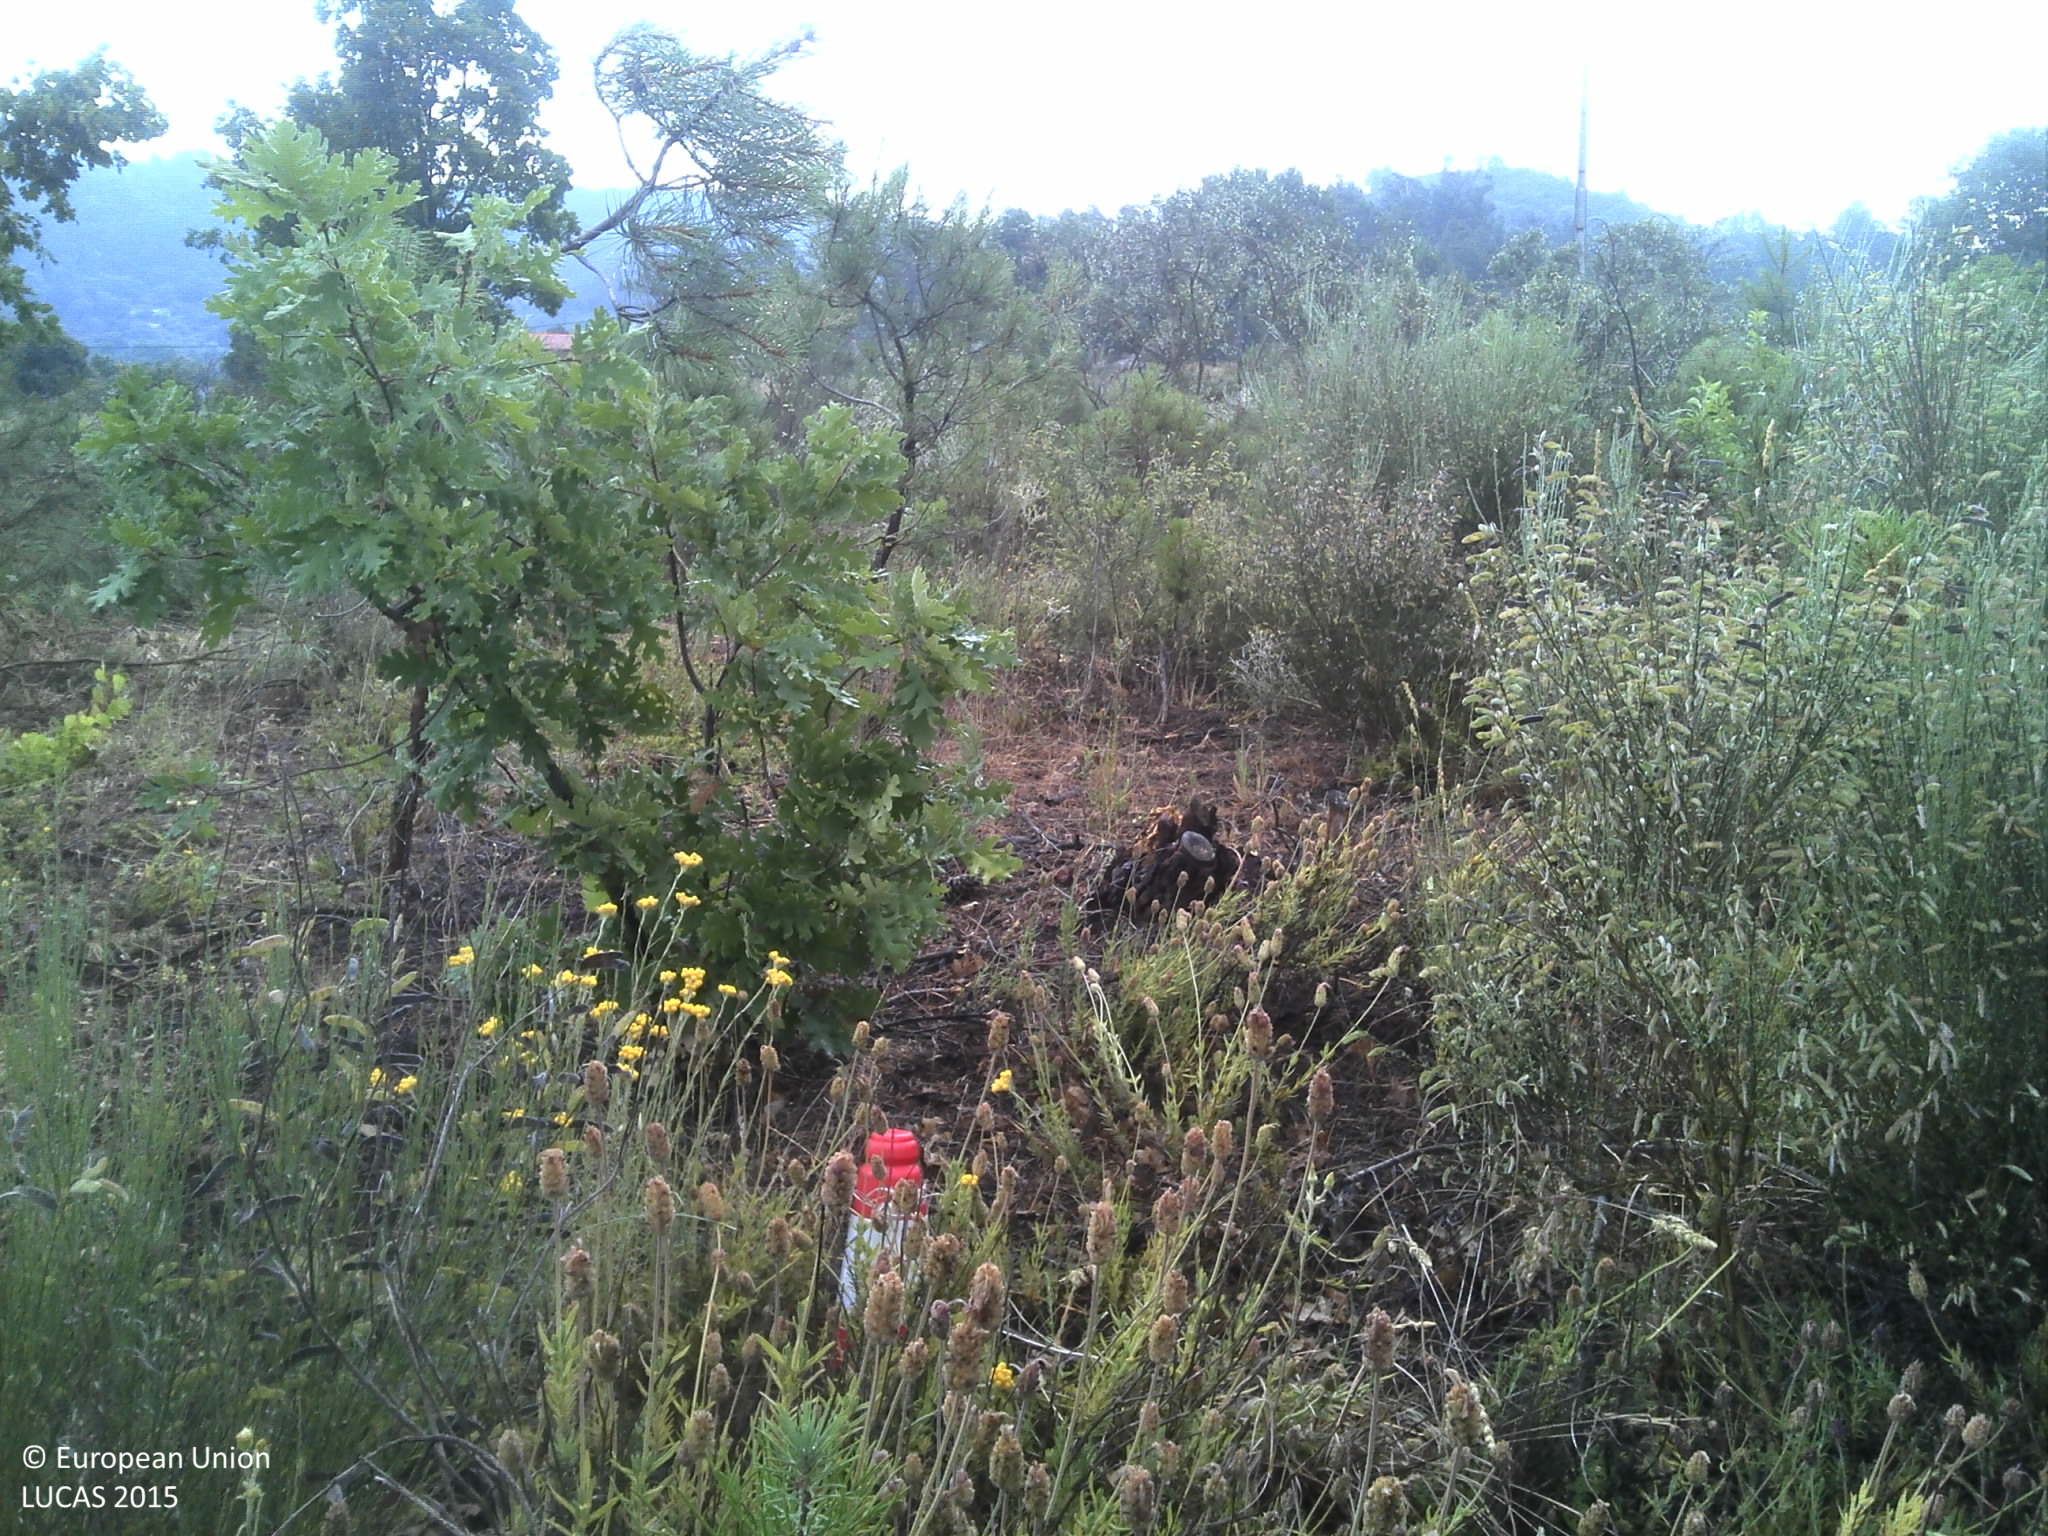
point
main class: Shrubland
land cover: Shrubland with sparse tree cover
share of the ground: 25 - 50 %
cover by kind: unconsolidated bare surface 45 %, shrubs 40 %, herbaceous plants 10 %, broadleaved forest trees 5 %
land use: Forestry
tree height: < 5 m
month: June
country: PT
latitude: 40.2062
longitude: -7.4336
